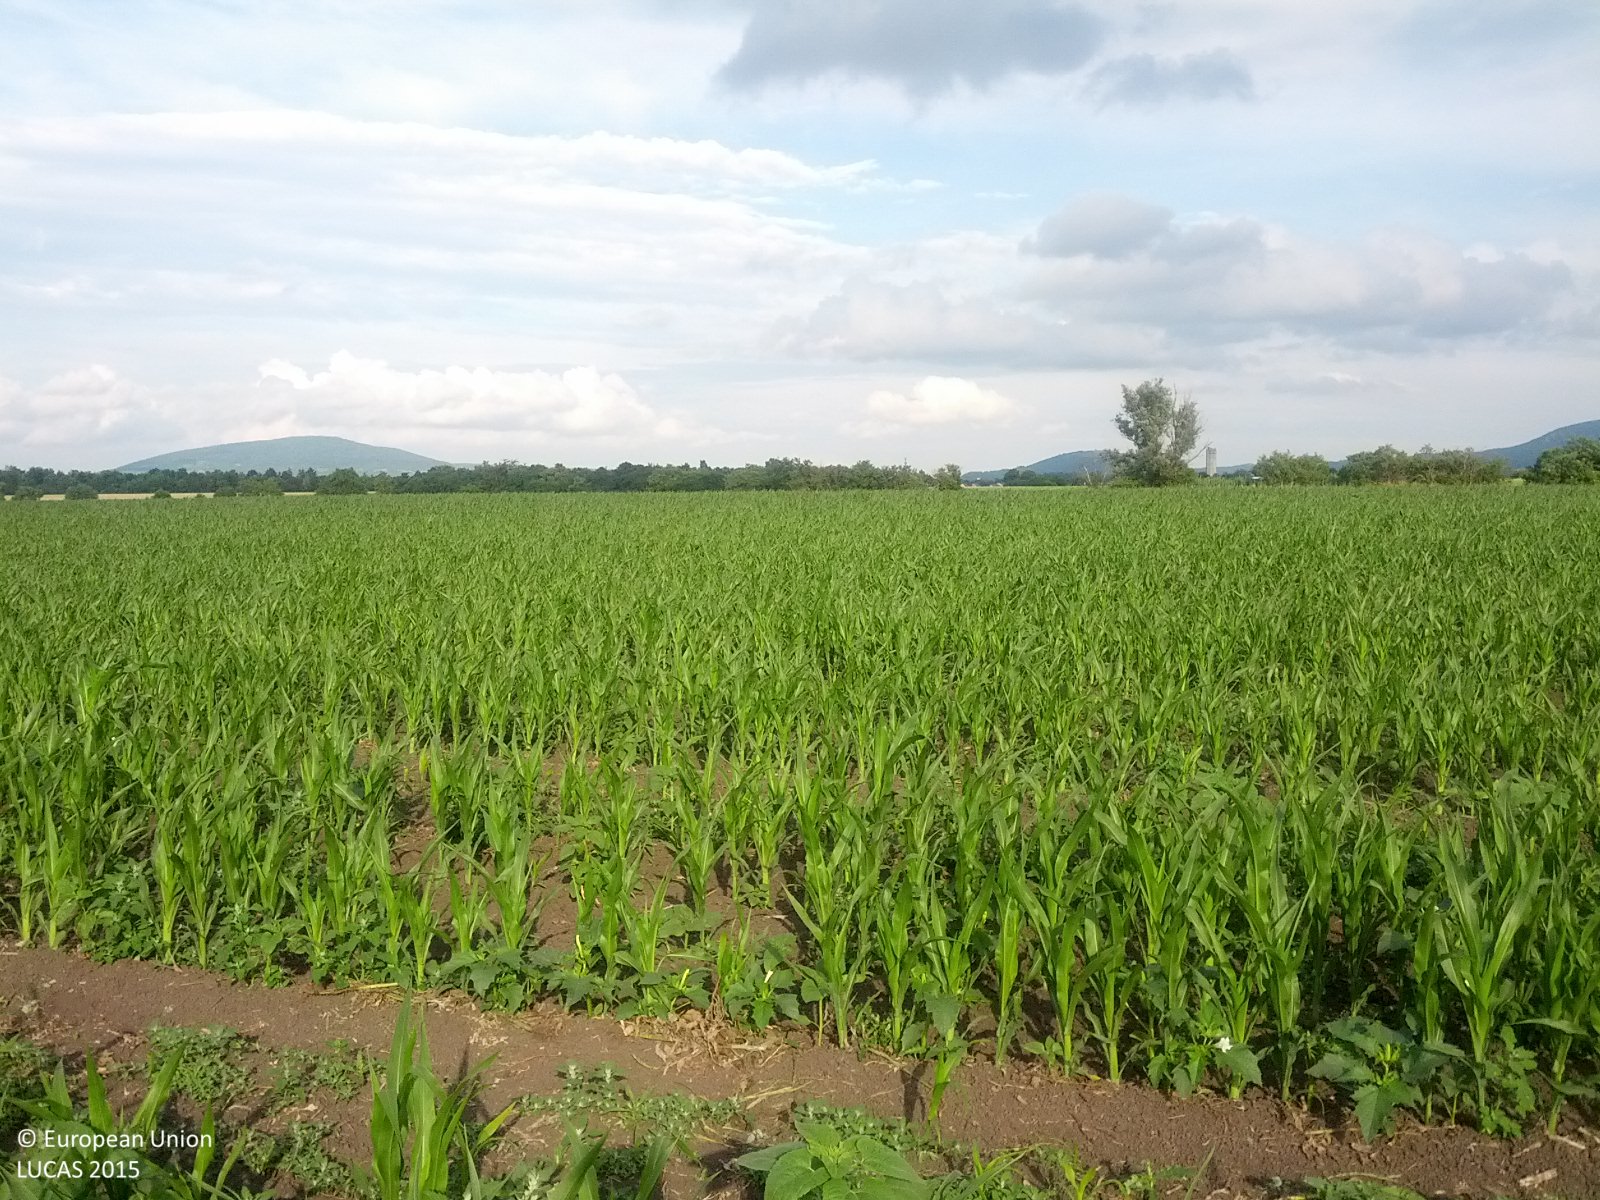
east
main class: Cropland
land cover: Rape and turnip rape
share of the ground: > 75 %
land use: Agriculture (excluding fallow land and kitchen gardens)
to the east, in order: Rape and turnip rape; Maize
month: June
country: AT
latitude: 48.1907
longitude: 16.8540
